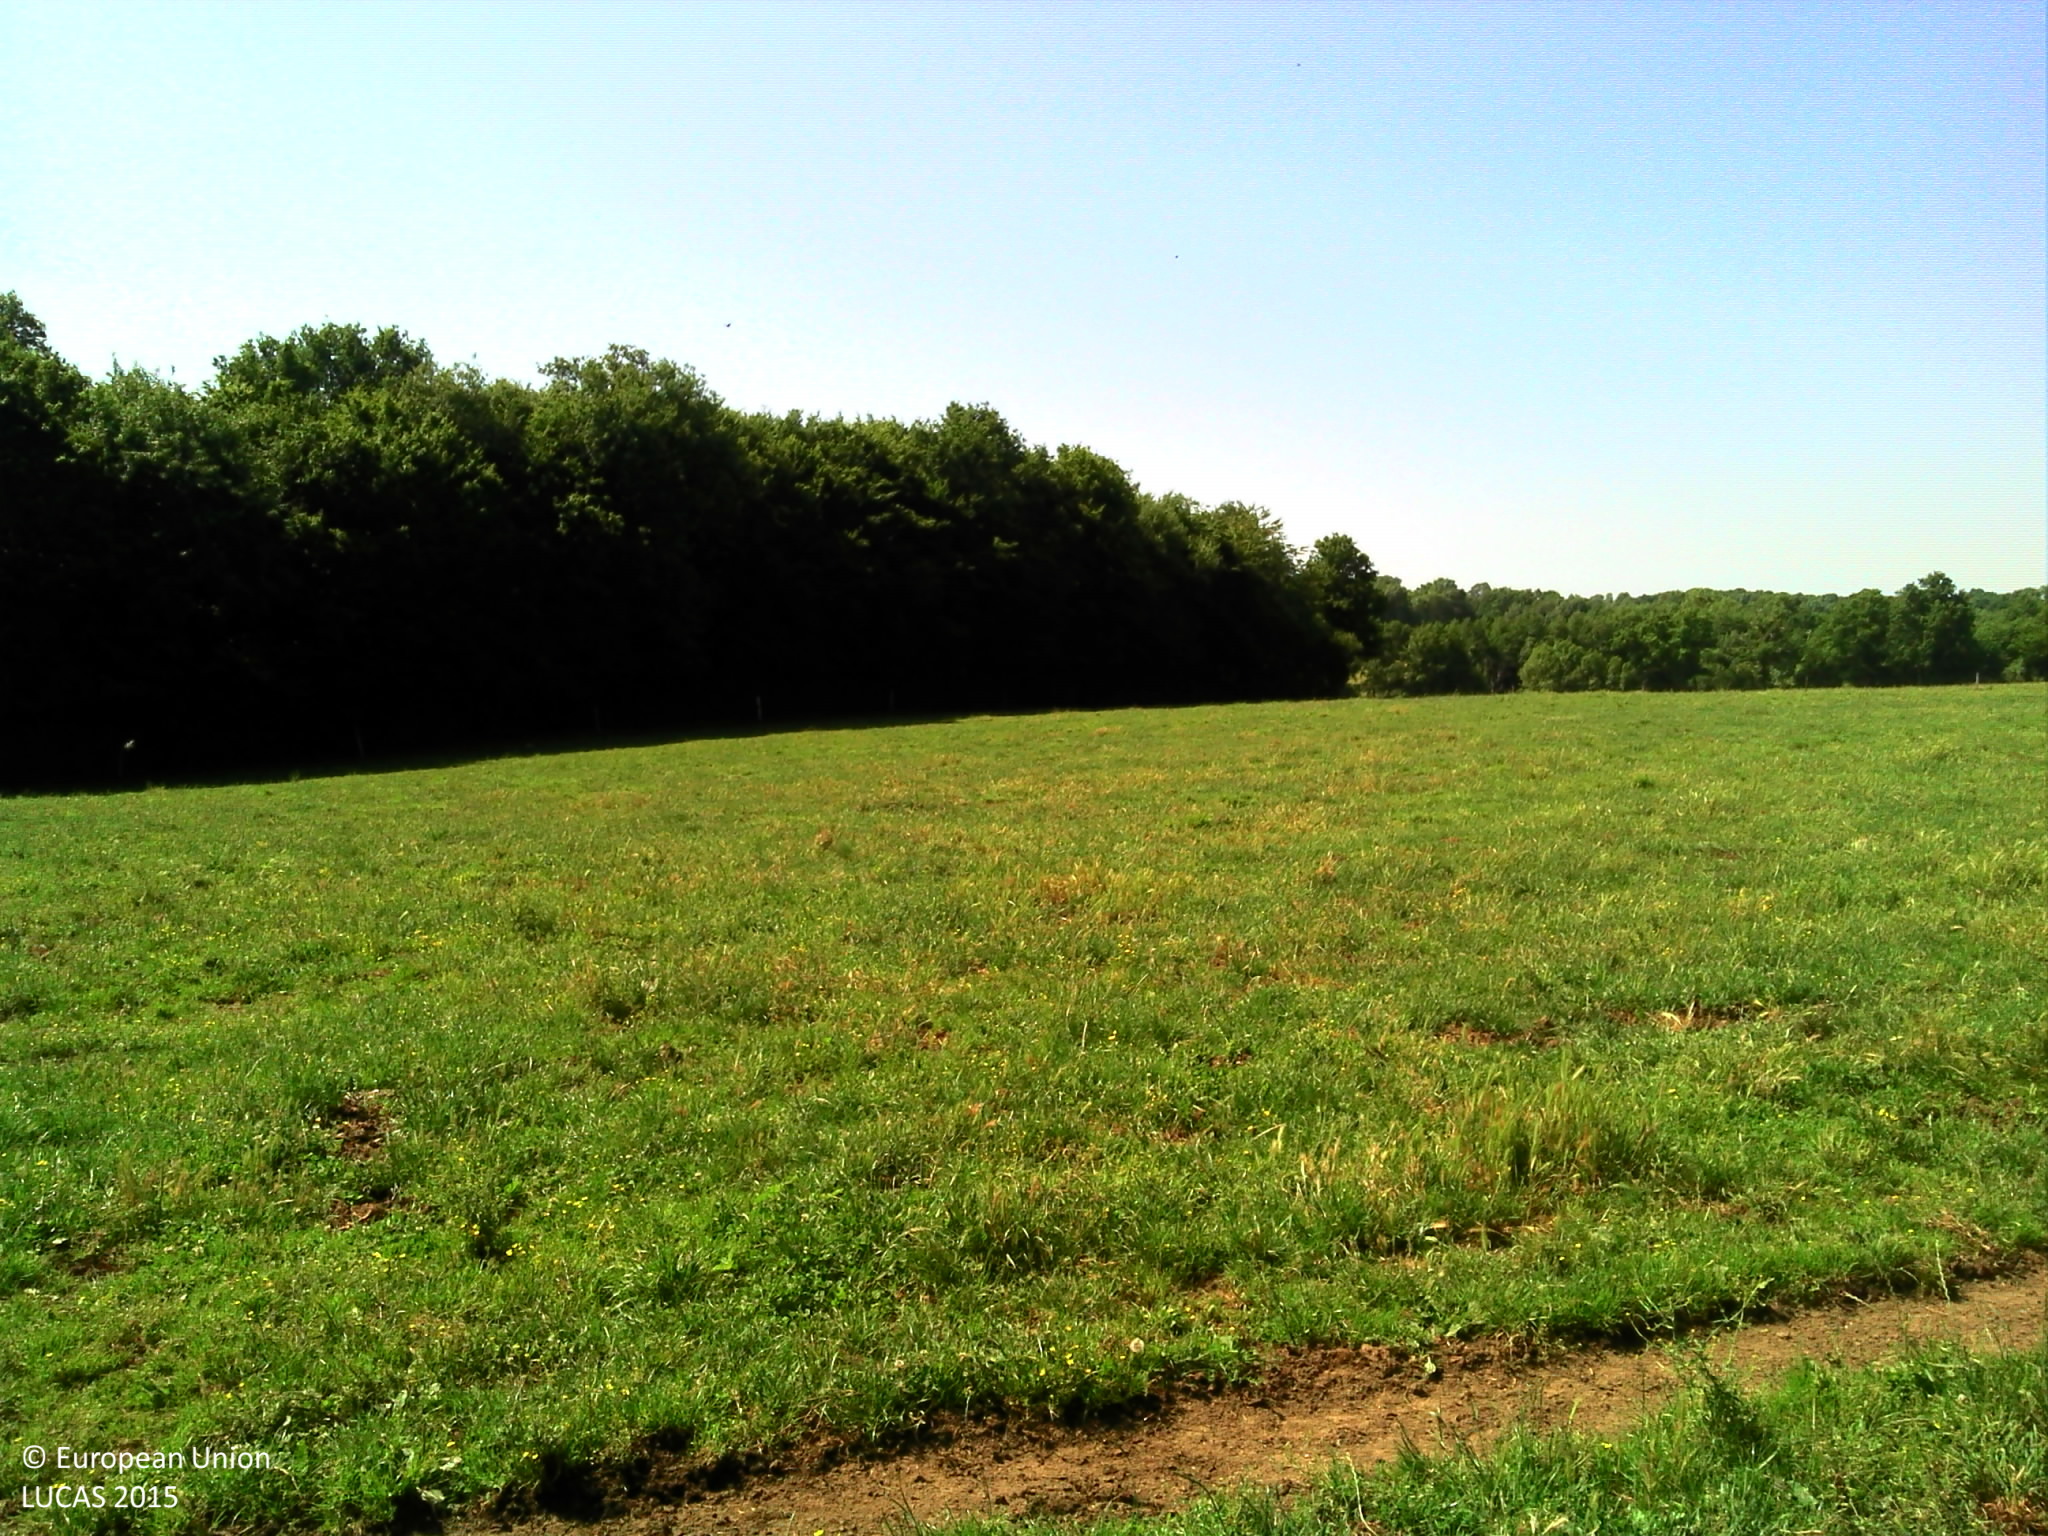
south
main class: Grassland
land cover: Grassland without tree/shrub cover
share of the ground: > 75 %
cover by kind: herbaceous plants 100 %
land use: Agriculture (excluding fallow land and kitchen gardens)
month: June
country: FR
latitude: 45.8814
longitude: 0.5928
